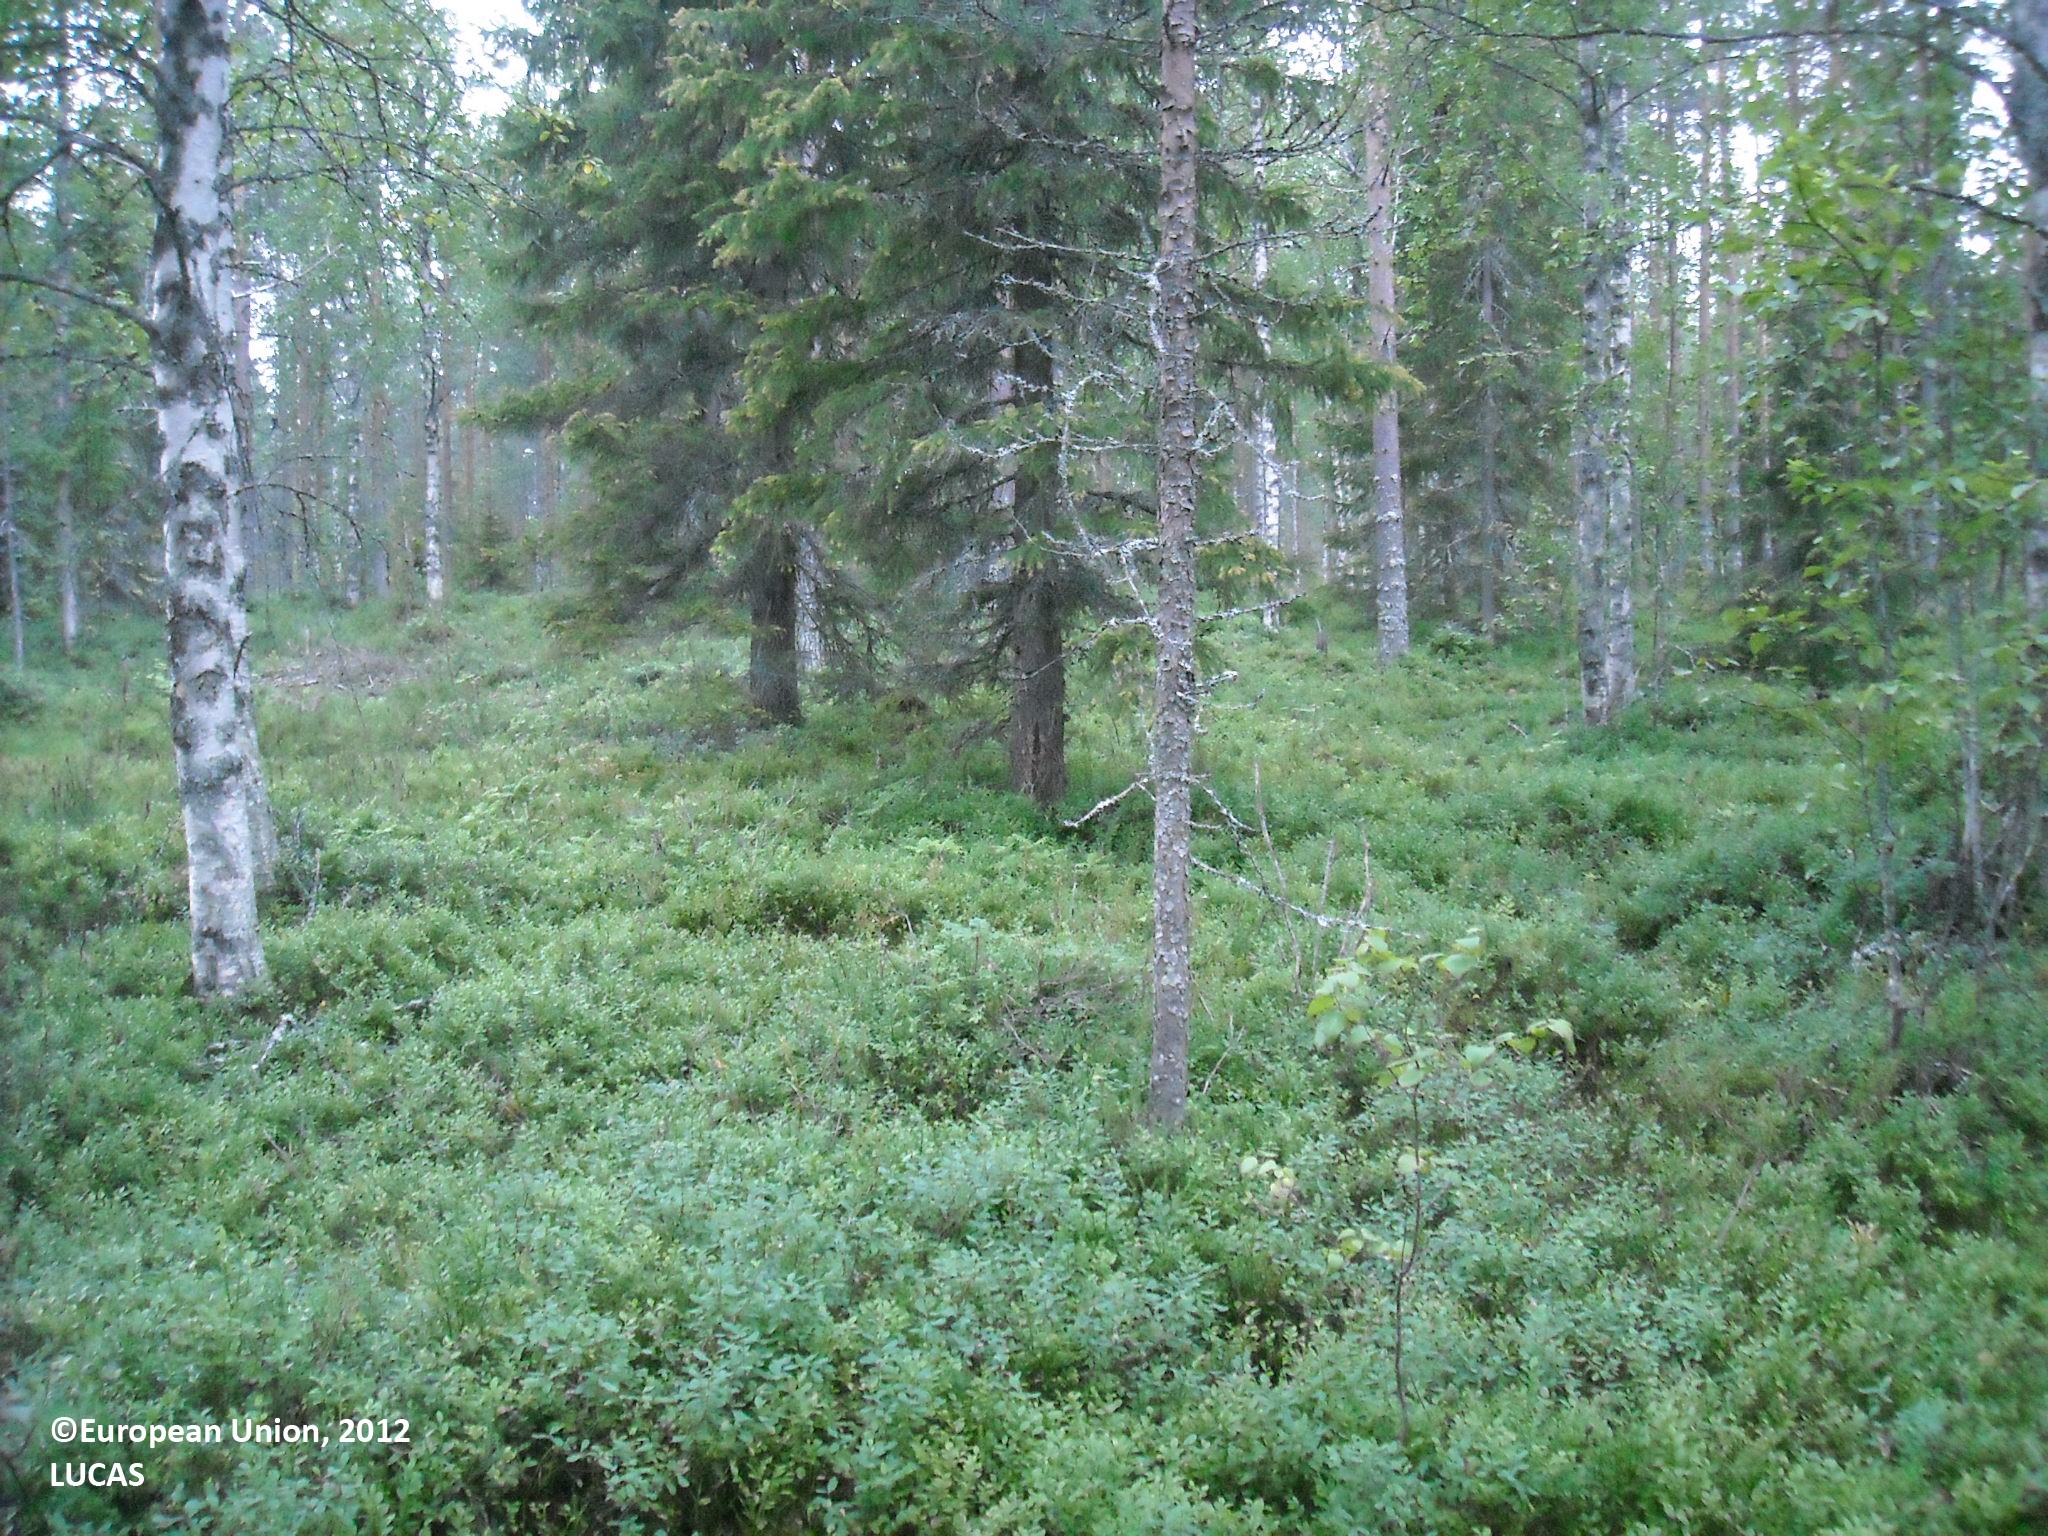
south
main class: Woodland
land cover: Other mixed woodland
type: mire and swamp forests
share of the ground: 50 - 75 %
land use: Forestry
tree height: > 5 m
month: August
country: FI
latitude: 65.1565
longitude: 27.5639
